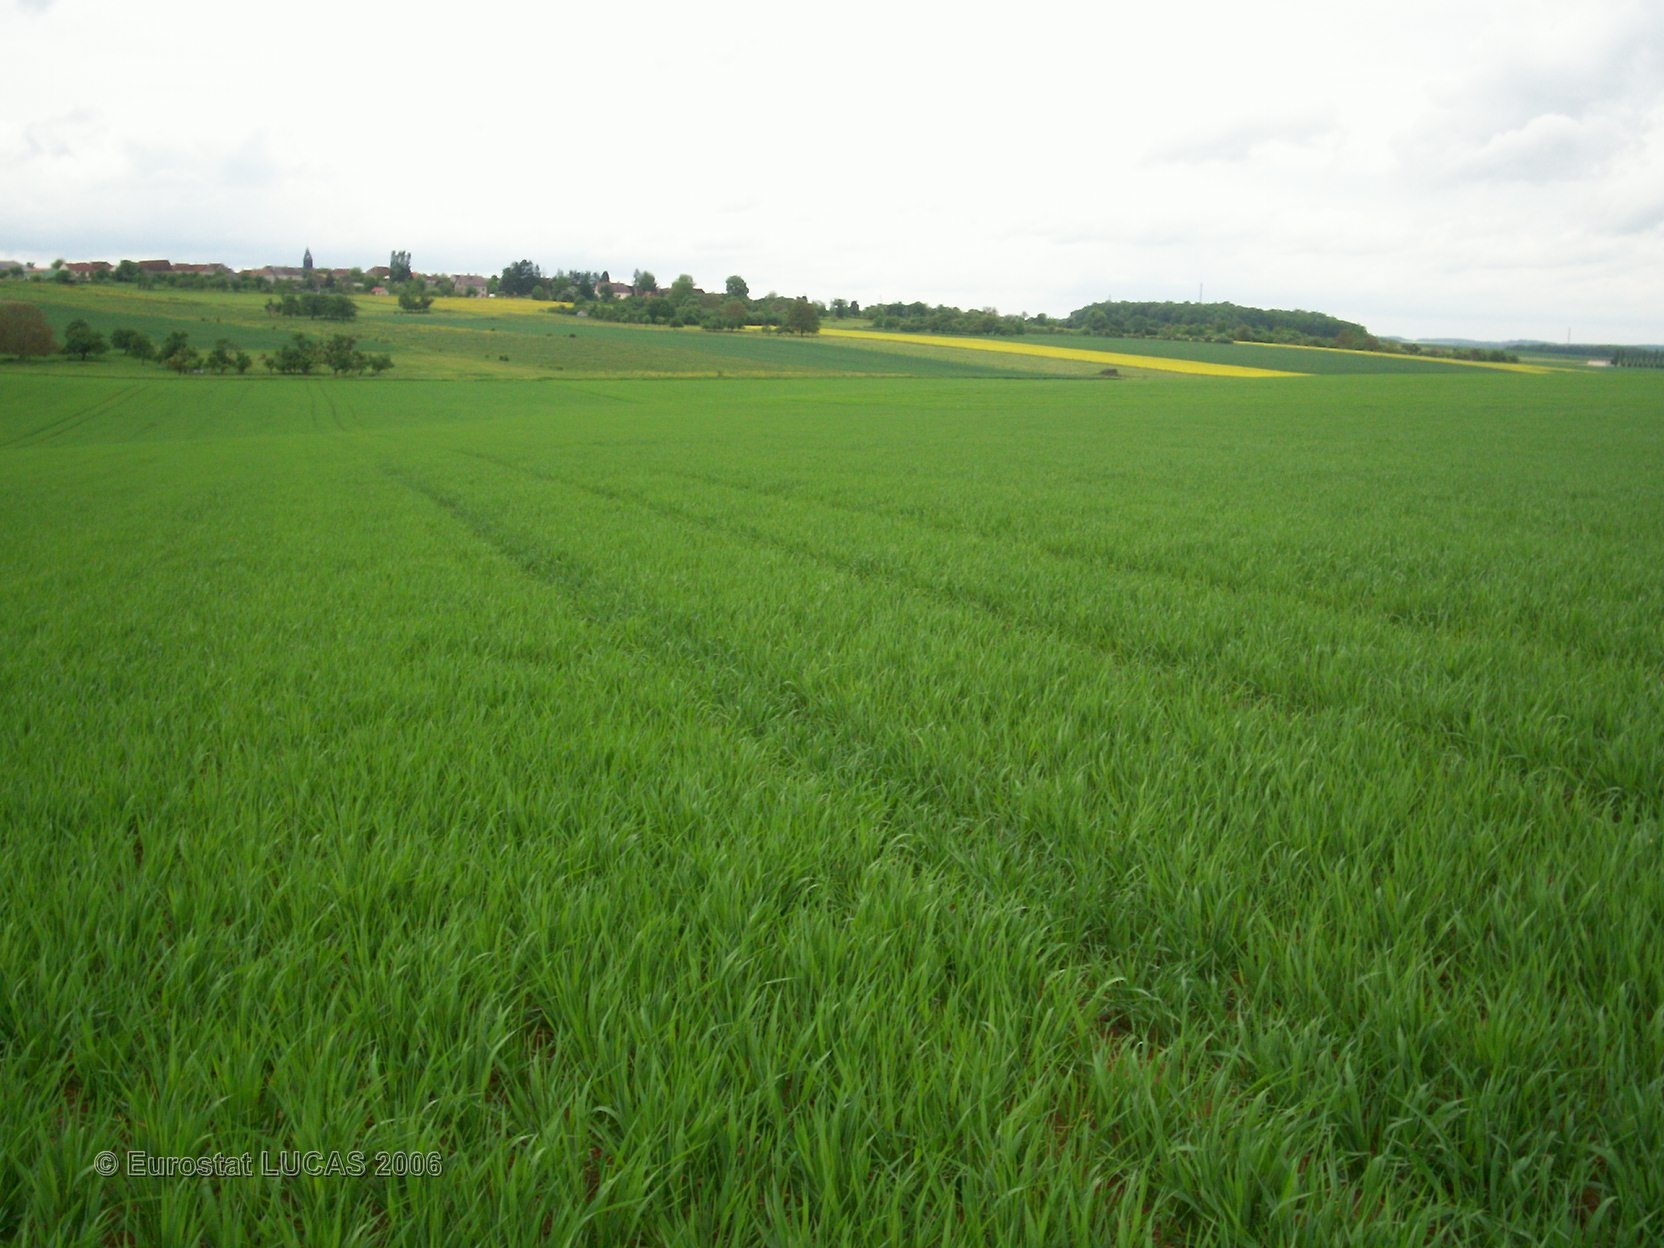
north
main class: Cropland
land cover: Barley
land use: Agriculture (excluding fallow land and kitchen gardens)
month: May
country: FR
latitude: 48.1750
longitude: 4.4705
